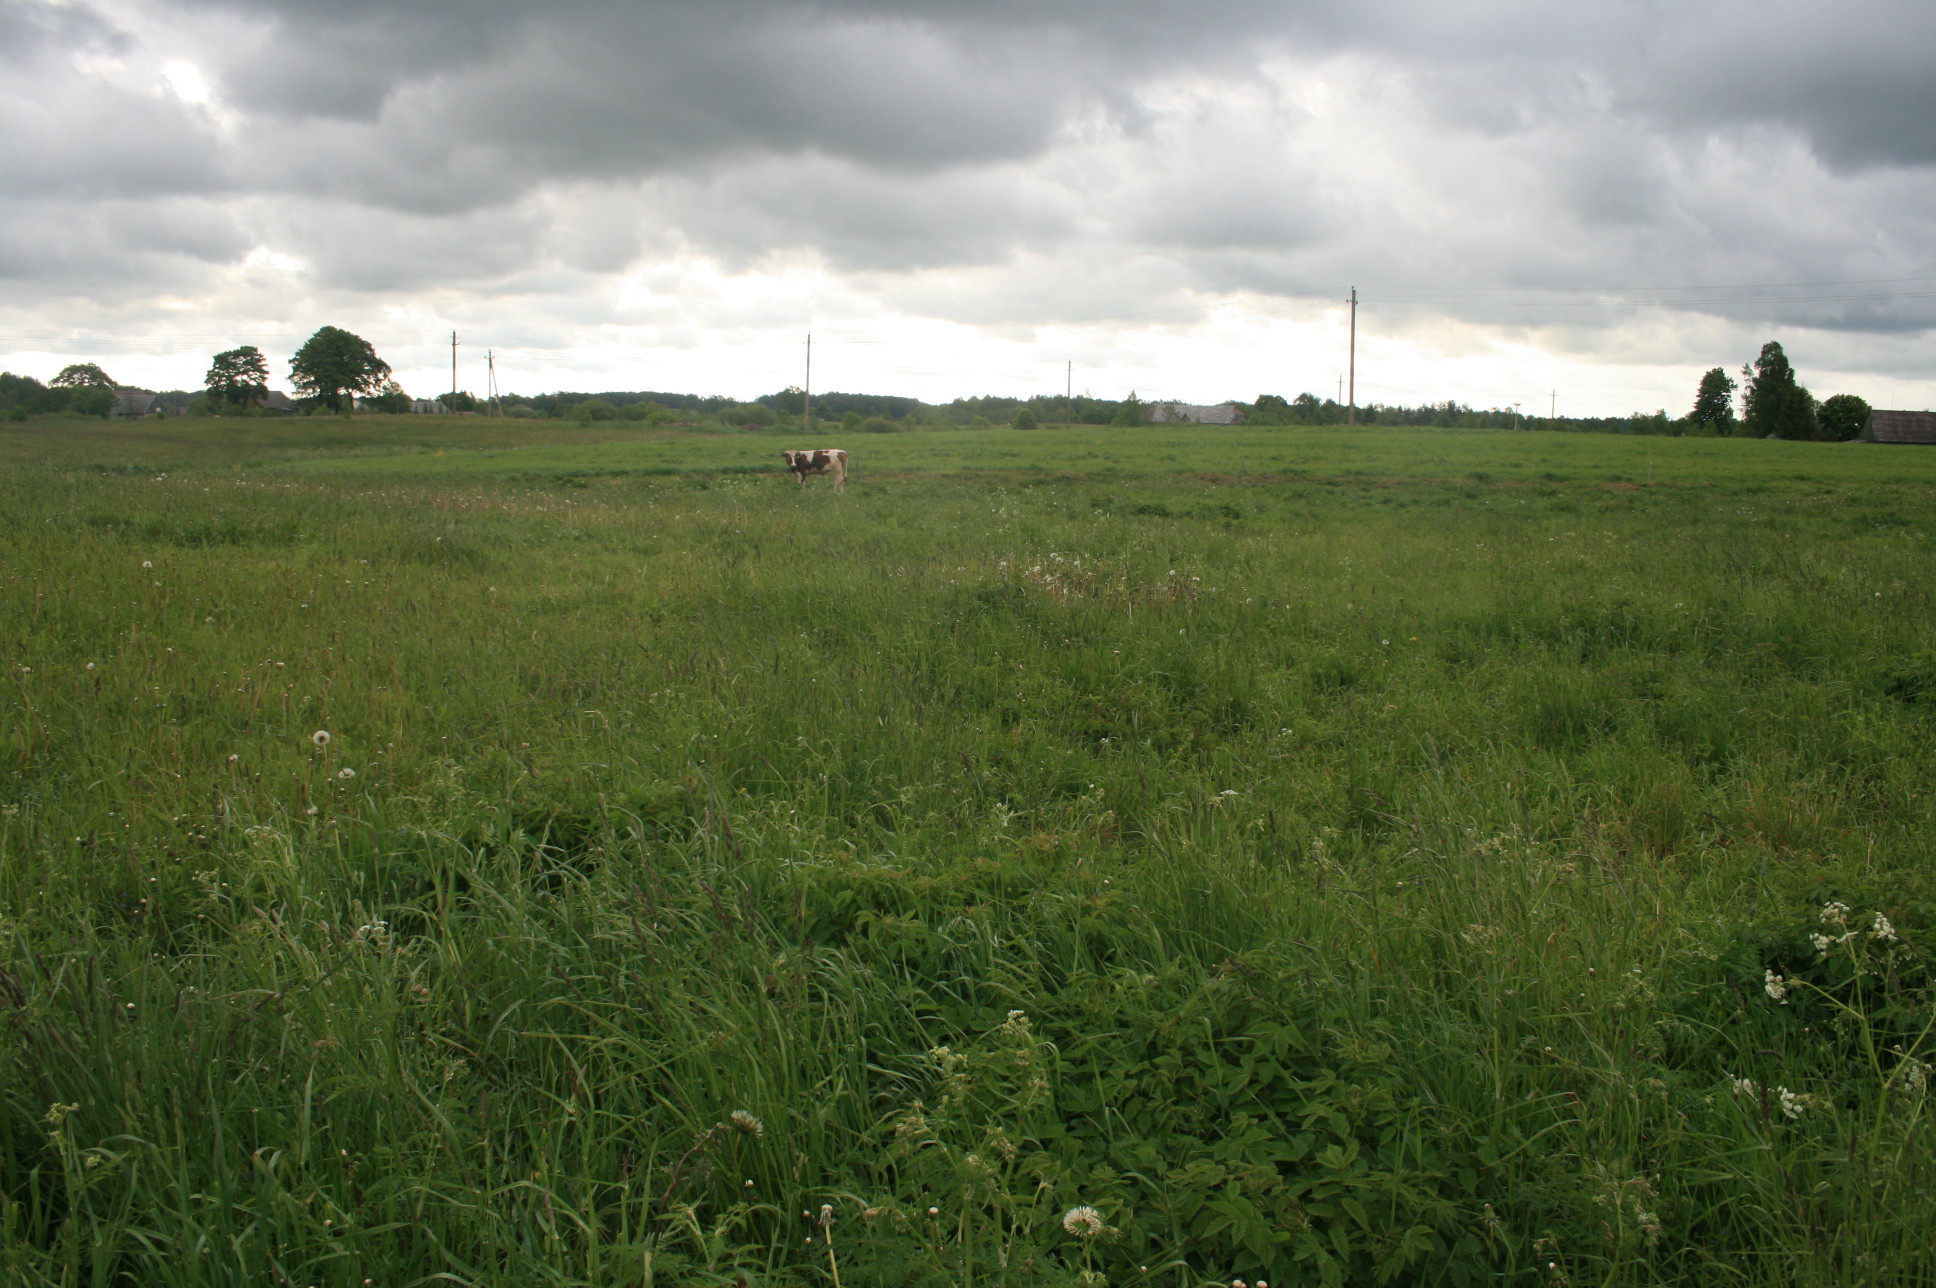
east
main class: Grassland
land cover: Grassland without tree/shrub cover
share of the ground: > 75 %
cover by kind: herbaceous plants 100 %
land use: Agriculture (excluding fallow land and kitchen gardens)
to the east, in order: Grassland without tree/shrub cover; Electric lines; Grassland without tree/shrub cover; Other leguminous and mixtures for fodder; Grassland without tree/shrub cover; Electric lines; Grassland without tree/shrub cover
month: May
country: LT
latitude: 55.9250
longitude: 21.8765
